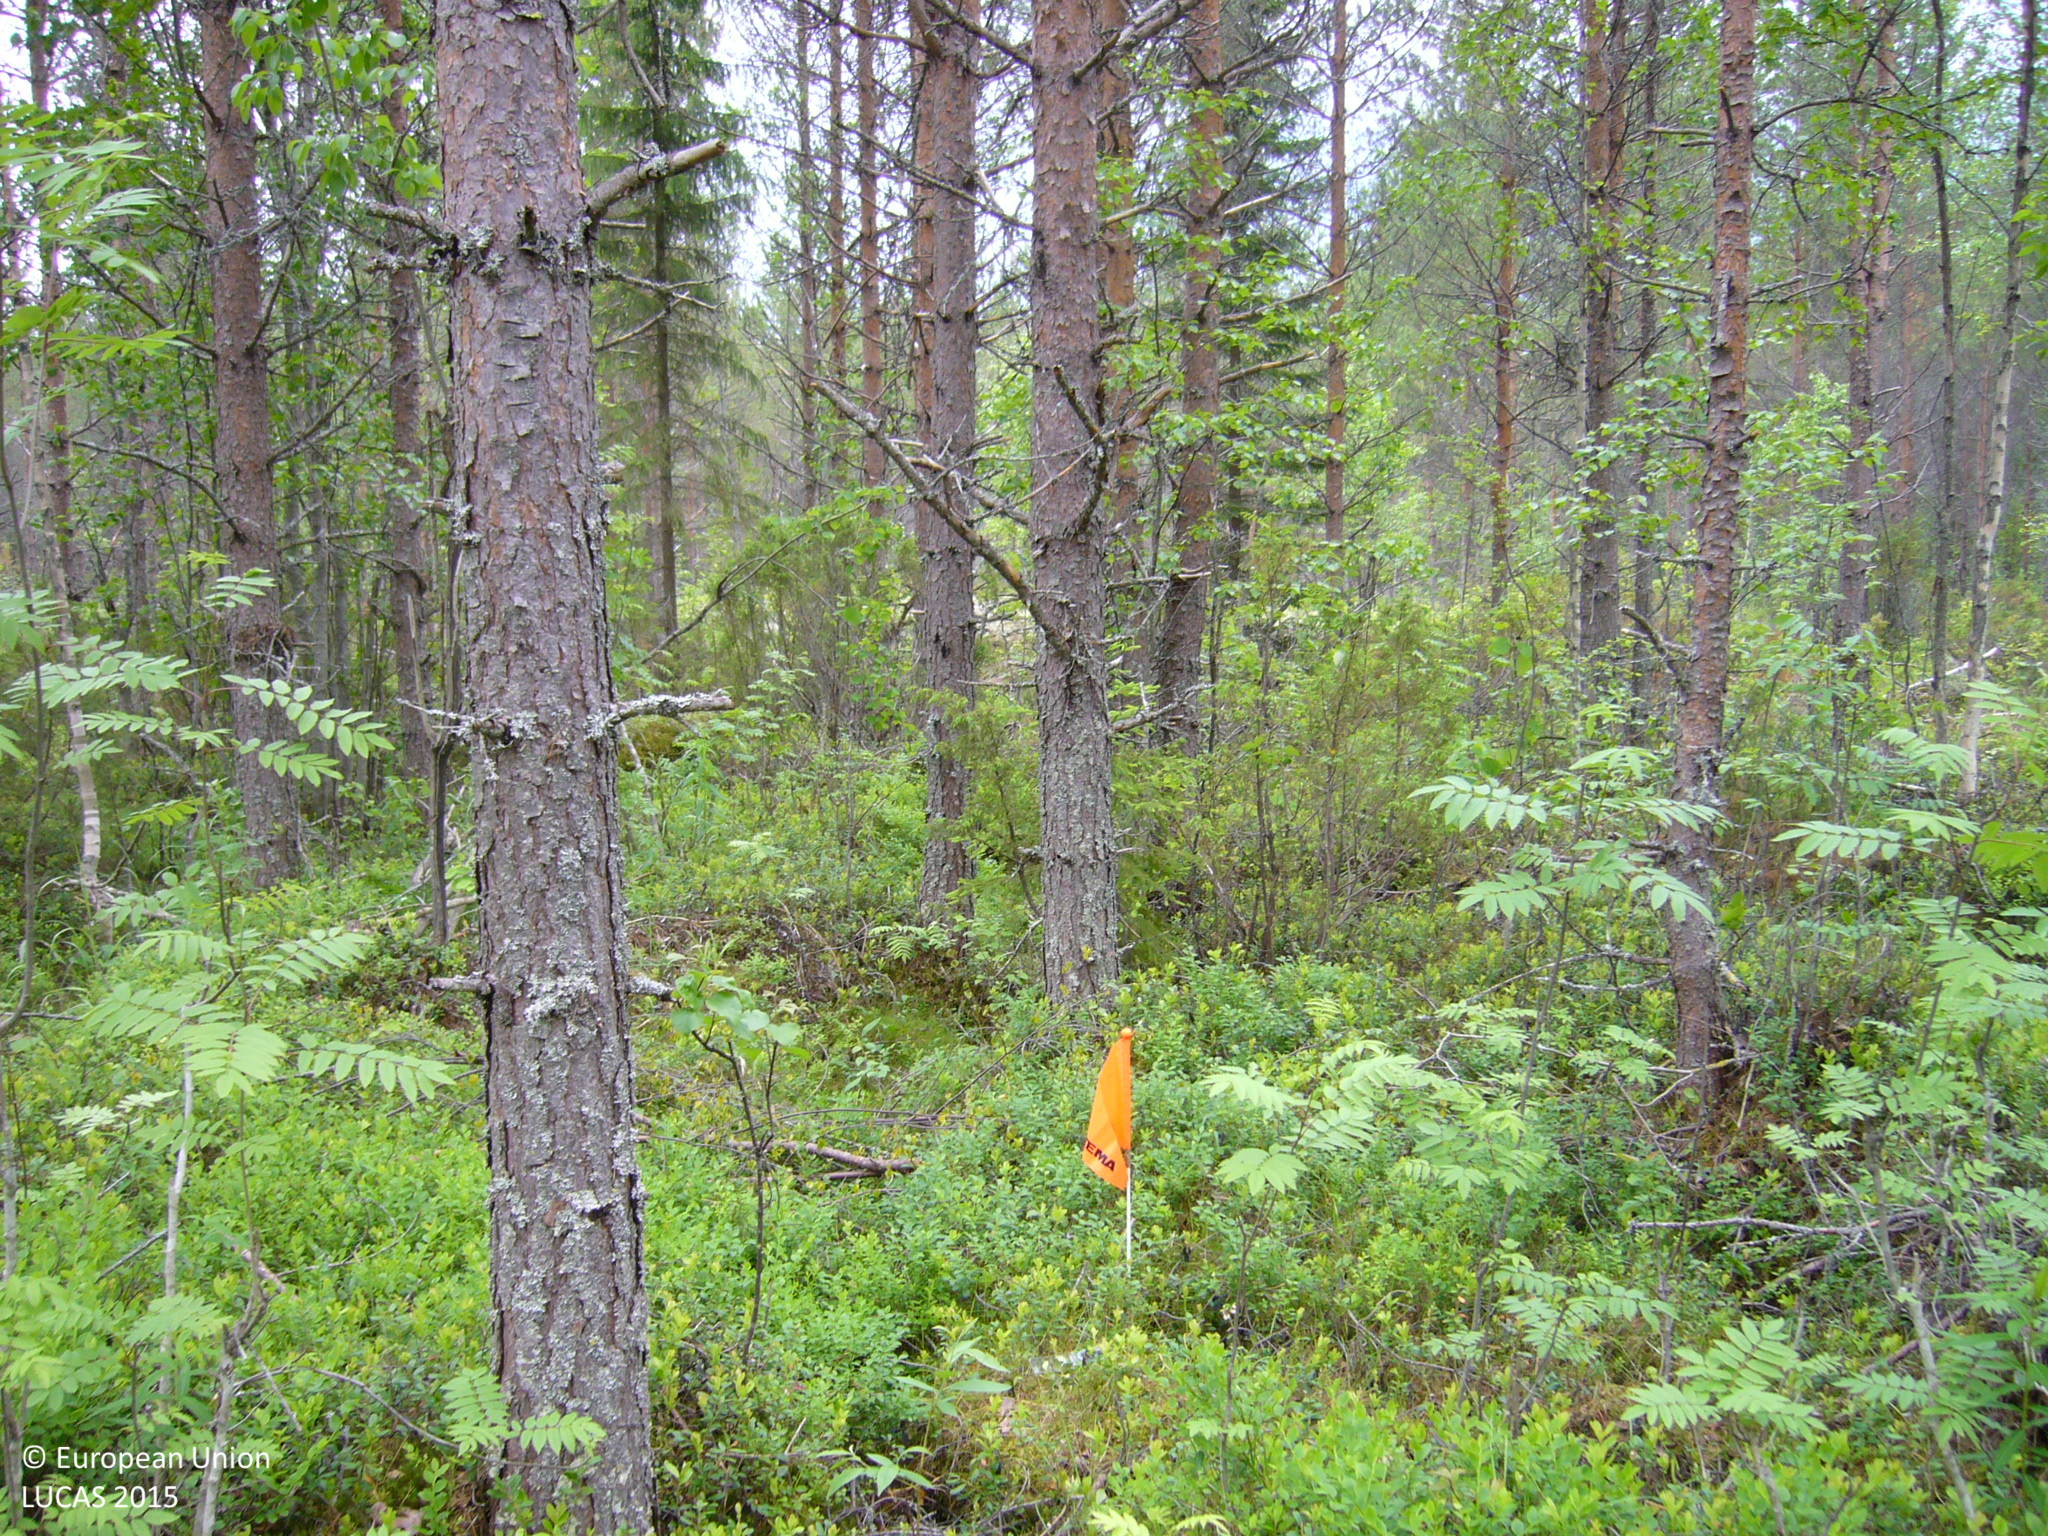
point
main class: Woodland
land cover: Pine dominated coniferous woodland
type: boreal forest
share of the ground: 50 - 75 %
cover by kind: coniferous forest trees 60 %, shrubs 35 %, broadleaved forest trees 5 %
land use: Forestry
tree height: > 5 m
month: June
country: FI
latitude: 63.7875
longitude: 26.1237
